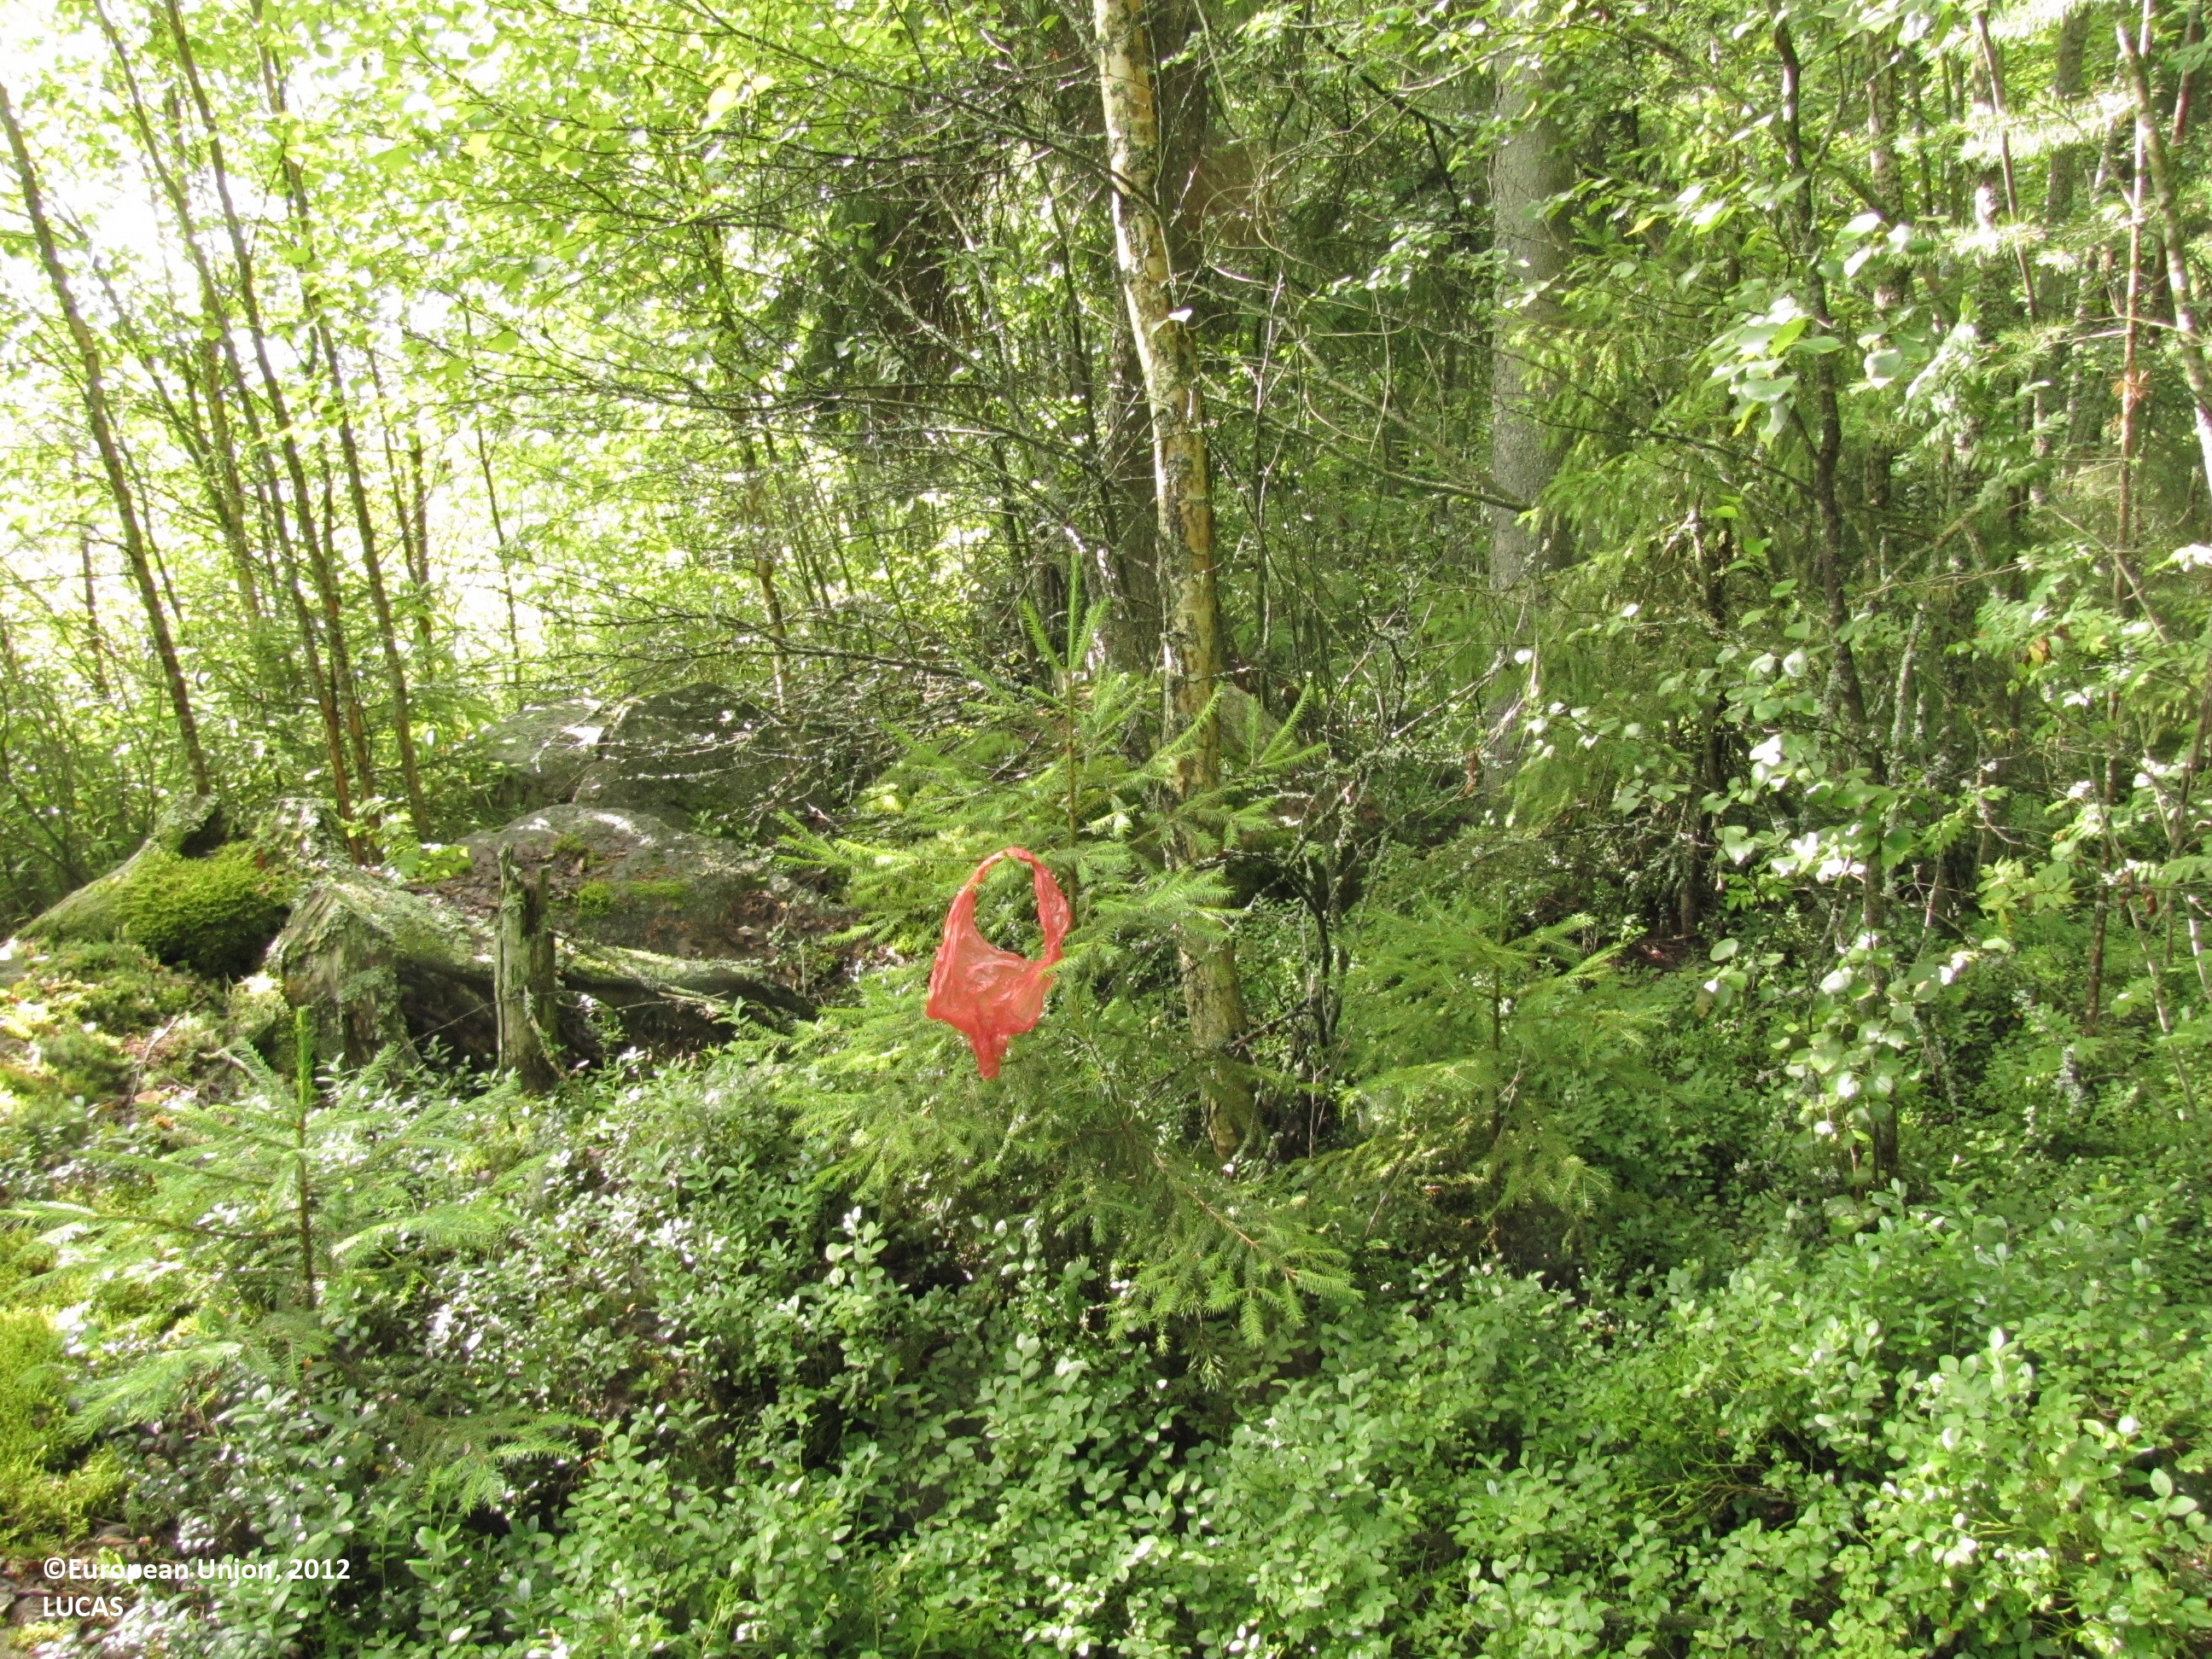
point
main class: Woodland
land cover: Pine dominated mixed woodland
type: boreal forest
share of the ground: 25 - 50 %
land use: Forestry
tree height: > 5 m
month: July
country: FI
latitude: 62.2036
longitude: 23.0801
